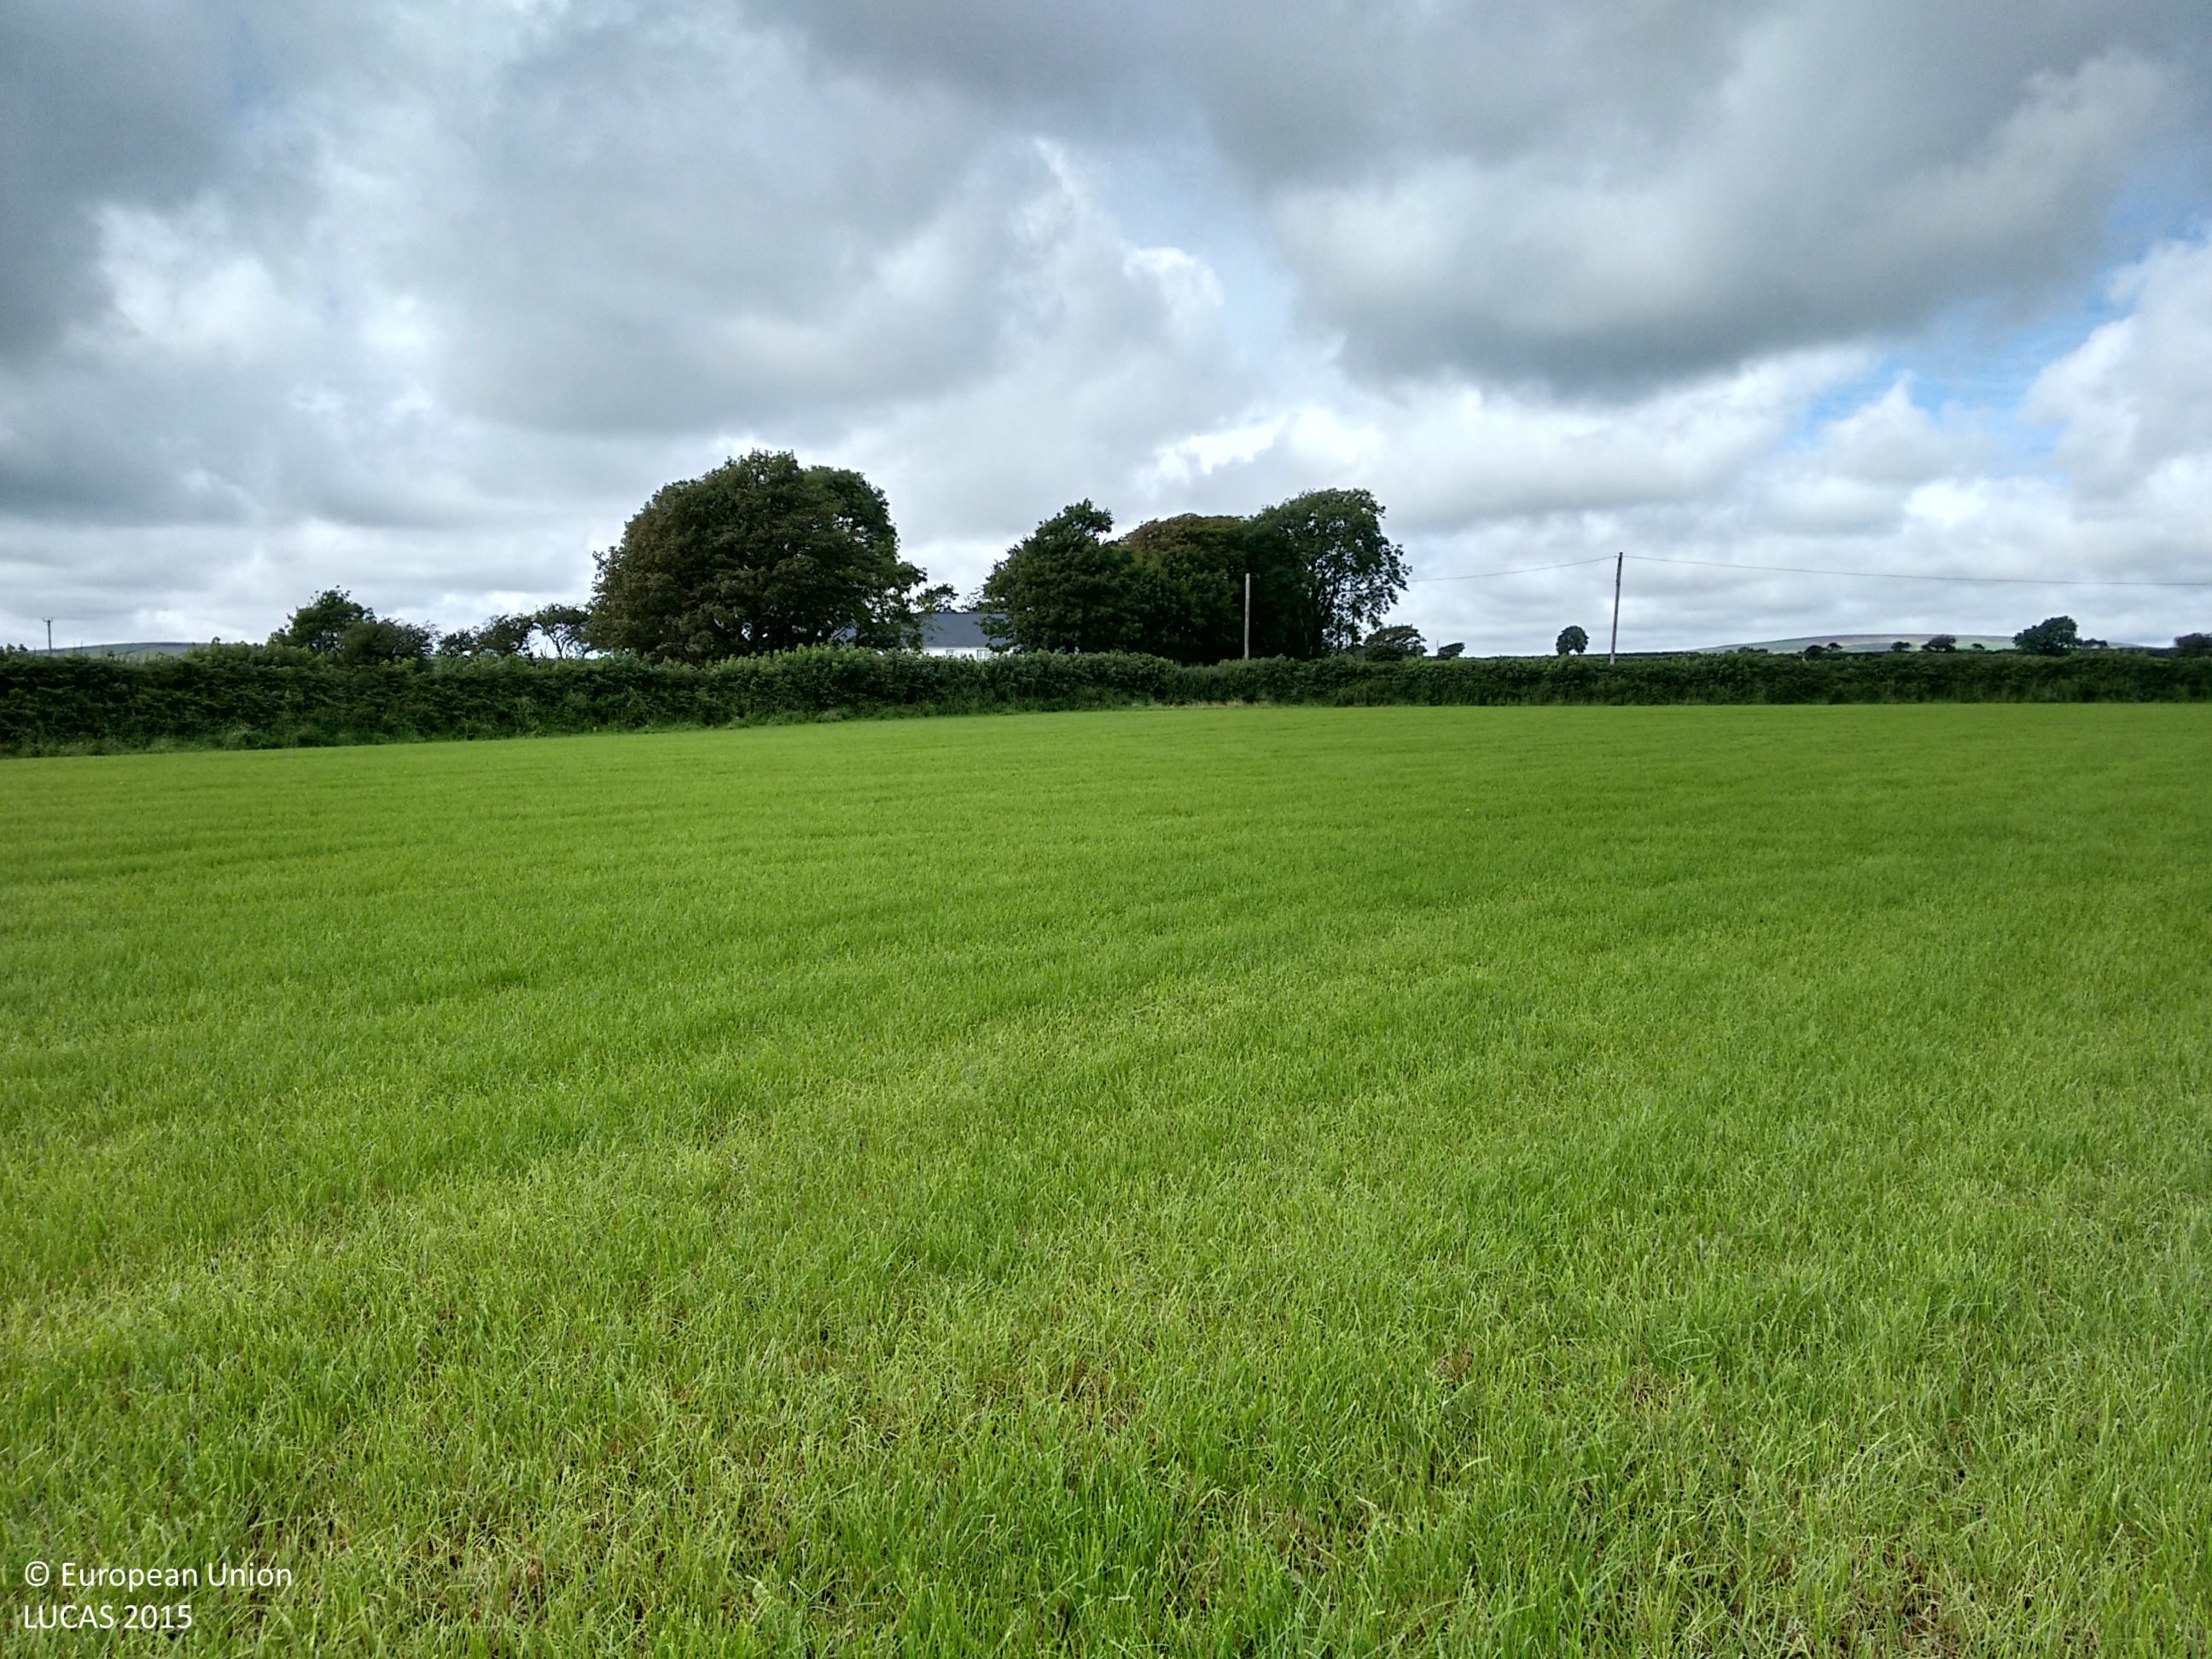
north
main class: Cropland
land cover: Temporary grasslands
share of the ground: > 75 %
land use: Agriculture (excluding fallow land and kitchen gardens)
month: August
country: GB
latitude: 51.9022
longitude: -4.9256
